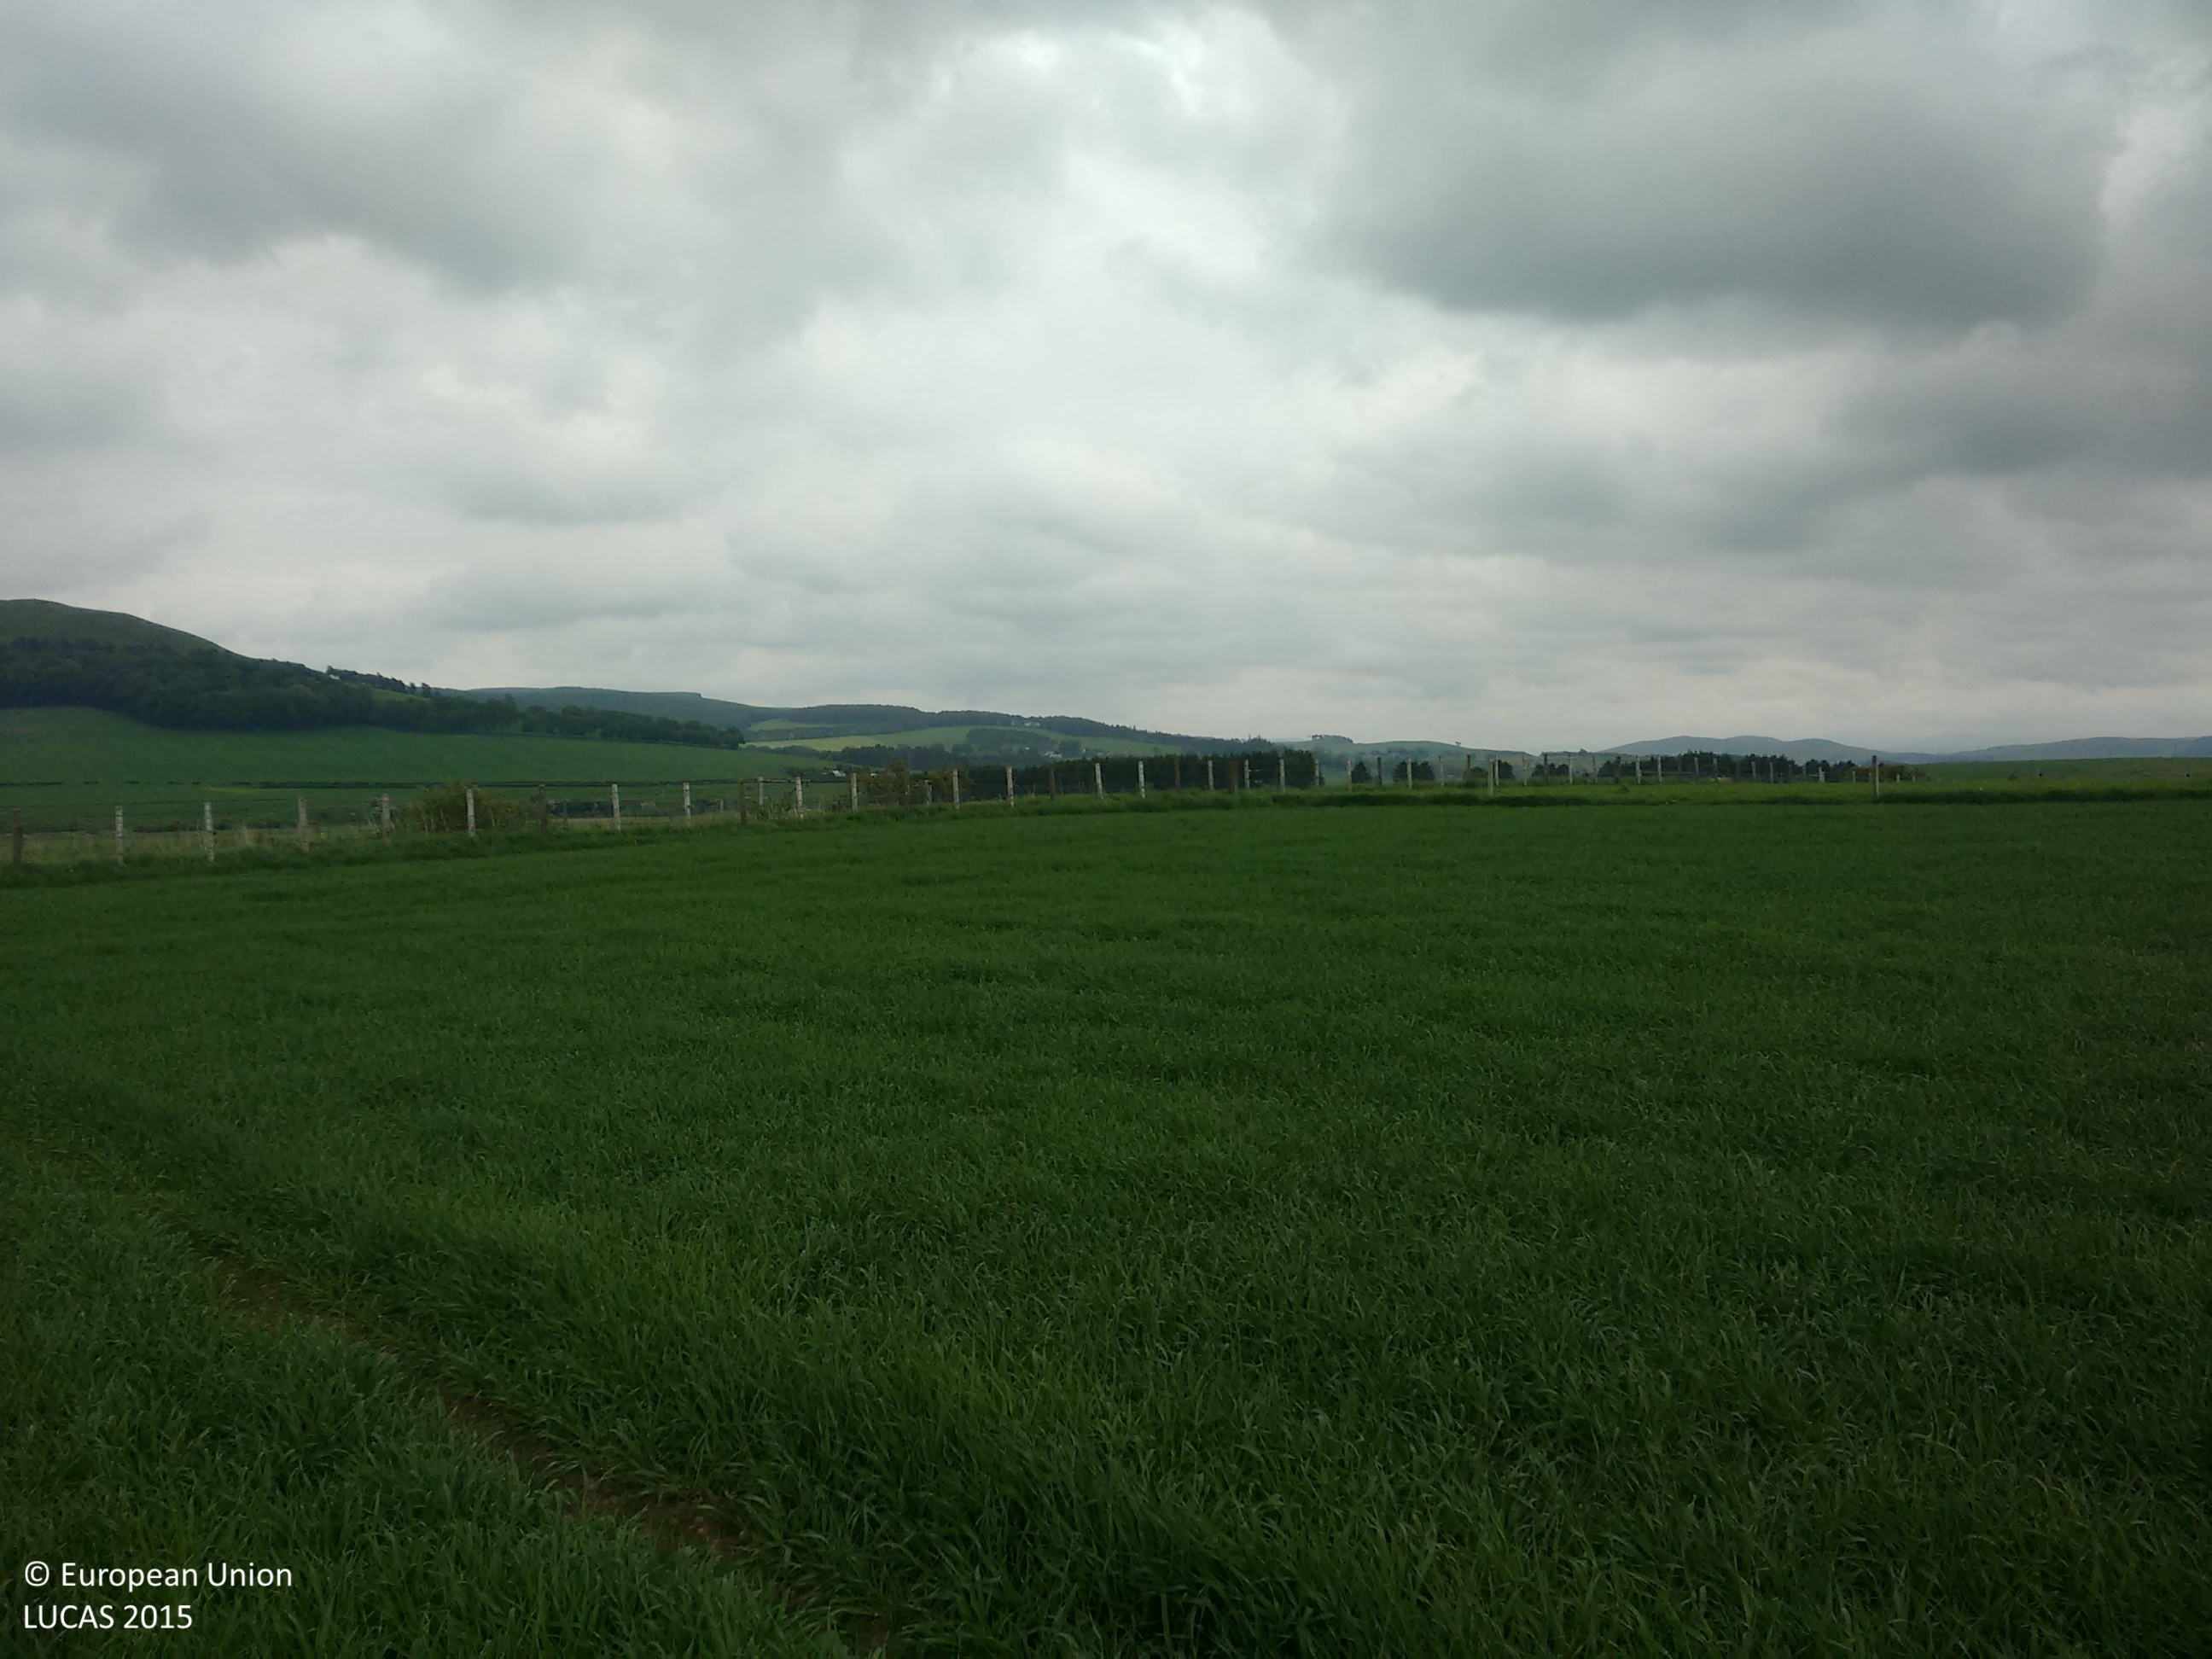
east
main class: Cropland
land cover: Barley
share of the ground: > 75 %
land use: Agriculture (excluding fallow land and kitchen gardens)
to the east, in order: Barley; Fences; Grass margins; Electric lines; Railways; Grass margins; Fences; Grassland without tree/shrub cover; Spontaneously vegetated surfaces
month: June
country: GB
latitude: 55.6206
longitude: -3.6262
